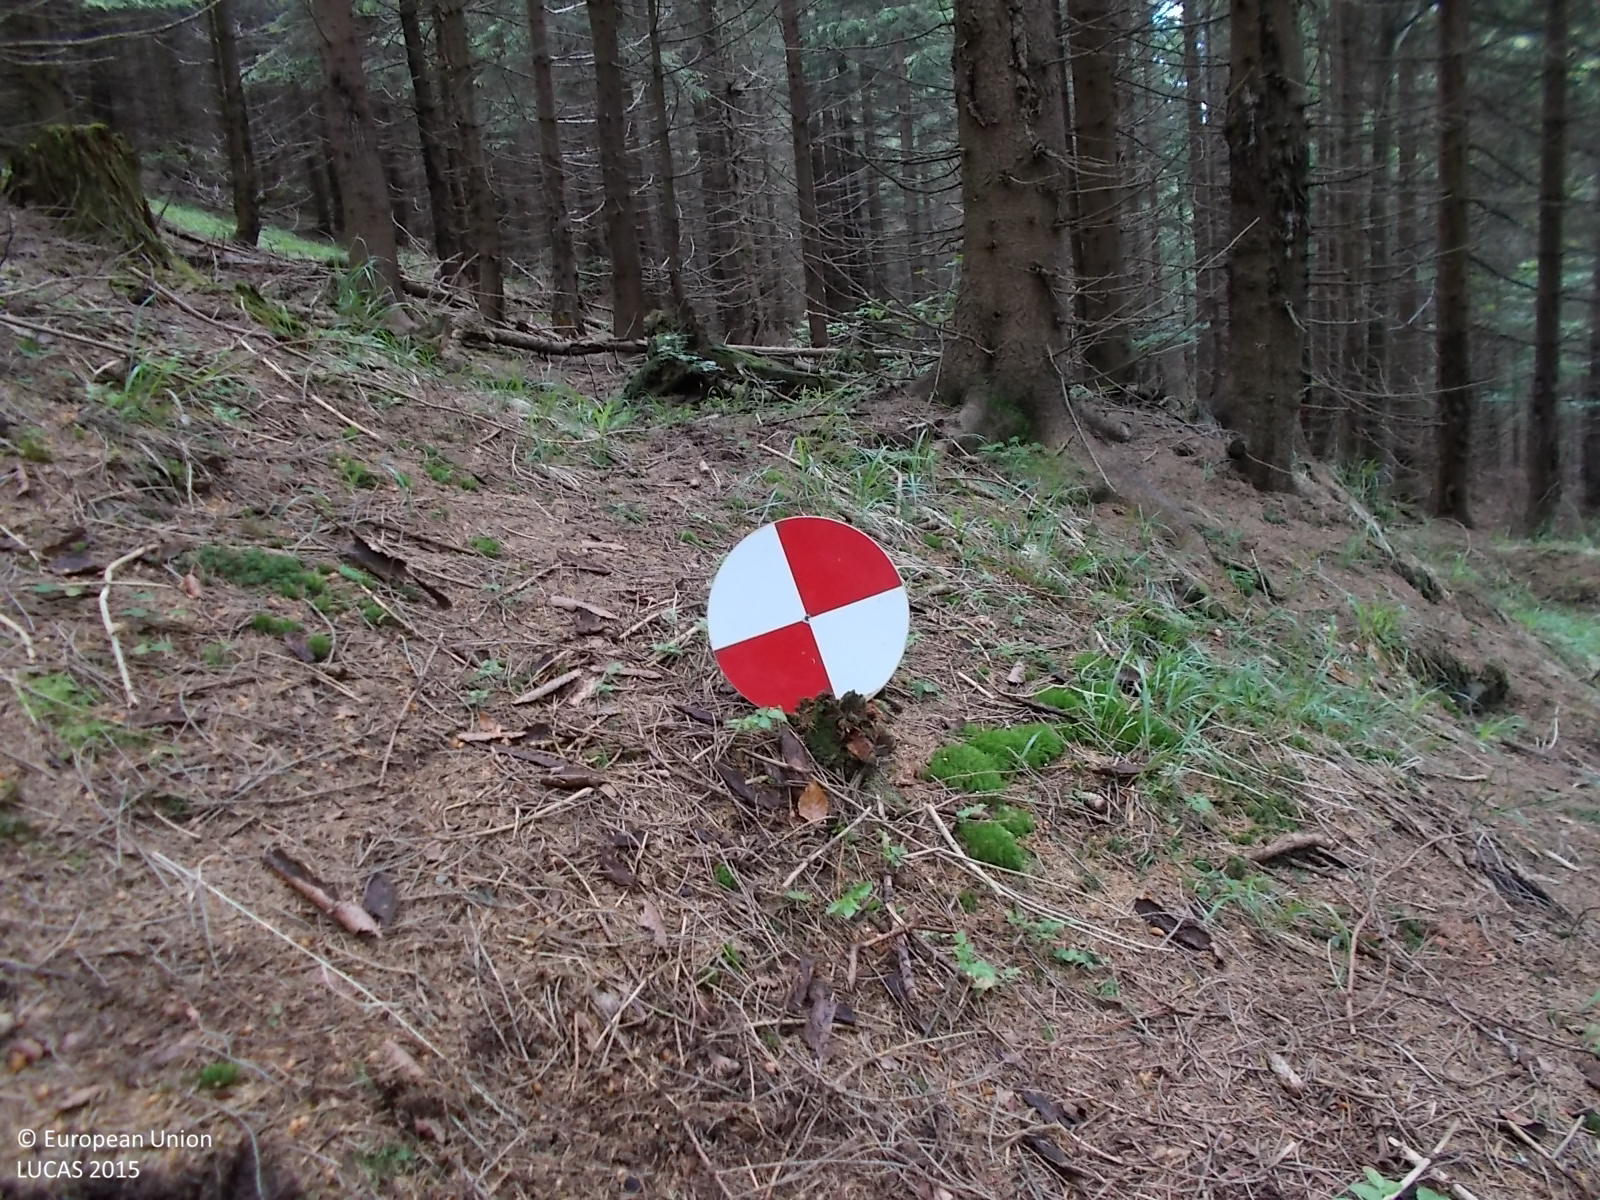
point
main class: Woodland
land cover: Spruce dominated coniferous woodland
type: hemiboreal forest and nemoral coniferous forest and mixed broadleaved-coniferous forest
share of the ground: > 75 %
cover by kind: coniferous forest trees 90 %, herbaceous plants 5 %, unconsolidated bare surface 5 %
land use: Forestry
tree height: > 5 m
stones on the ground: < 10 %
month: June
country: CZ
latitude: 50.1771
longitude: 17.1380
